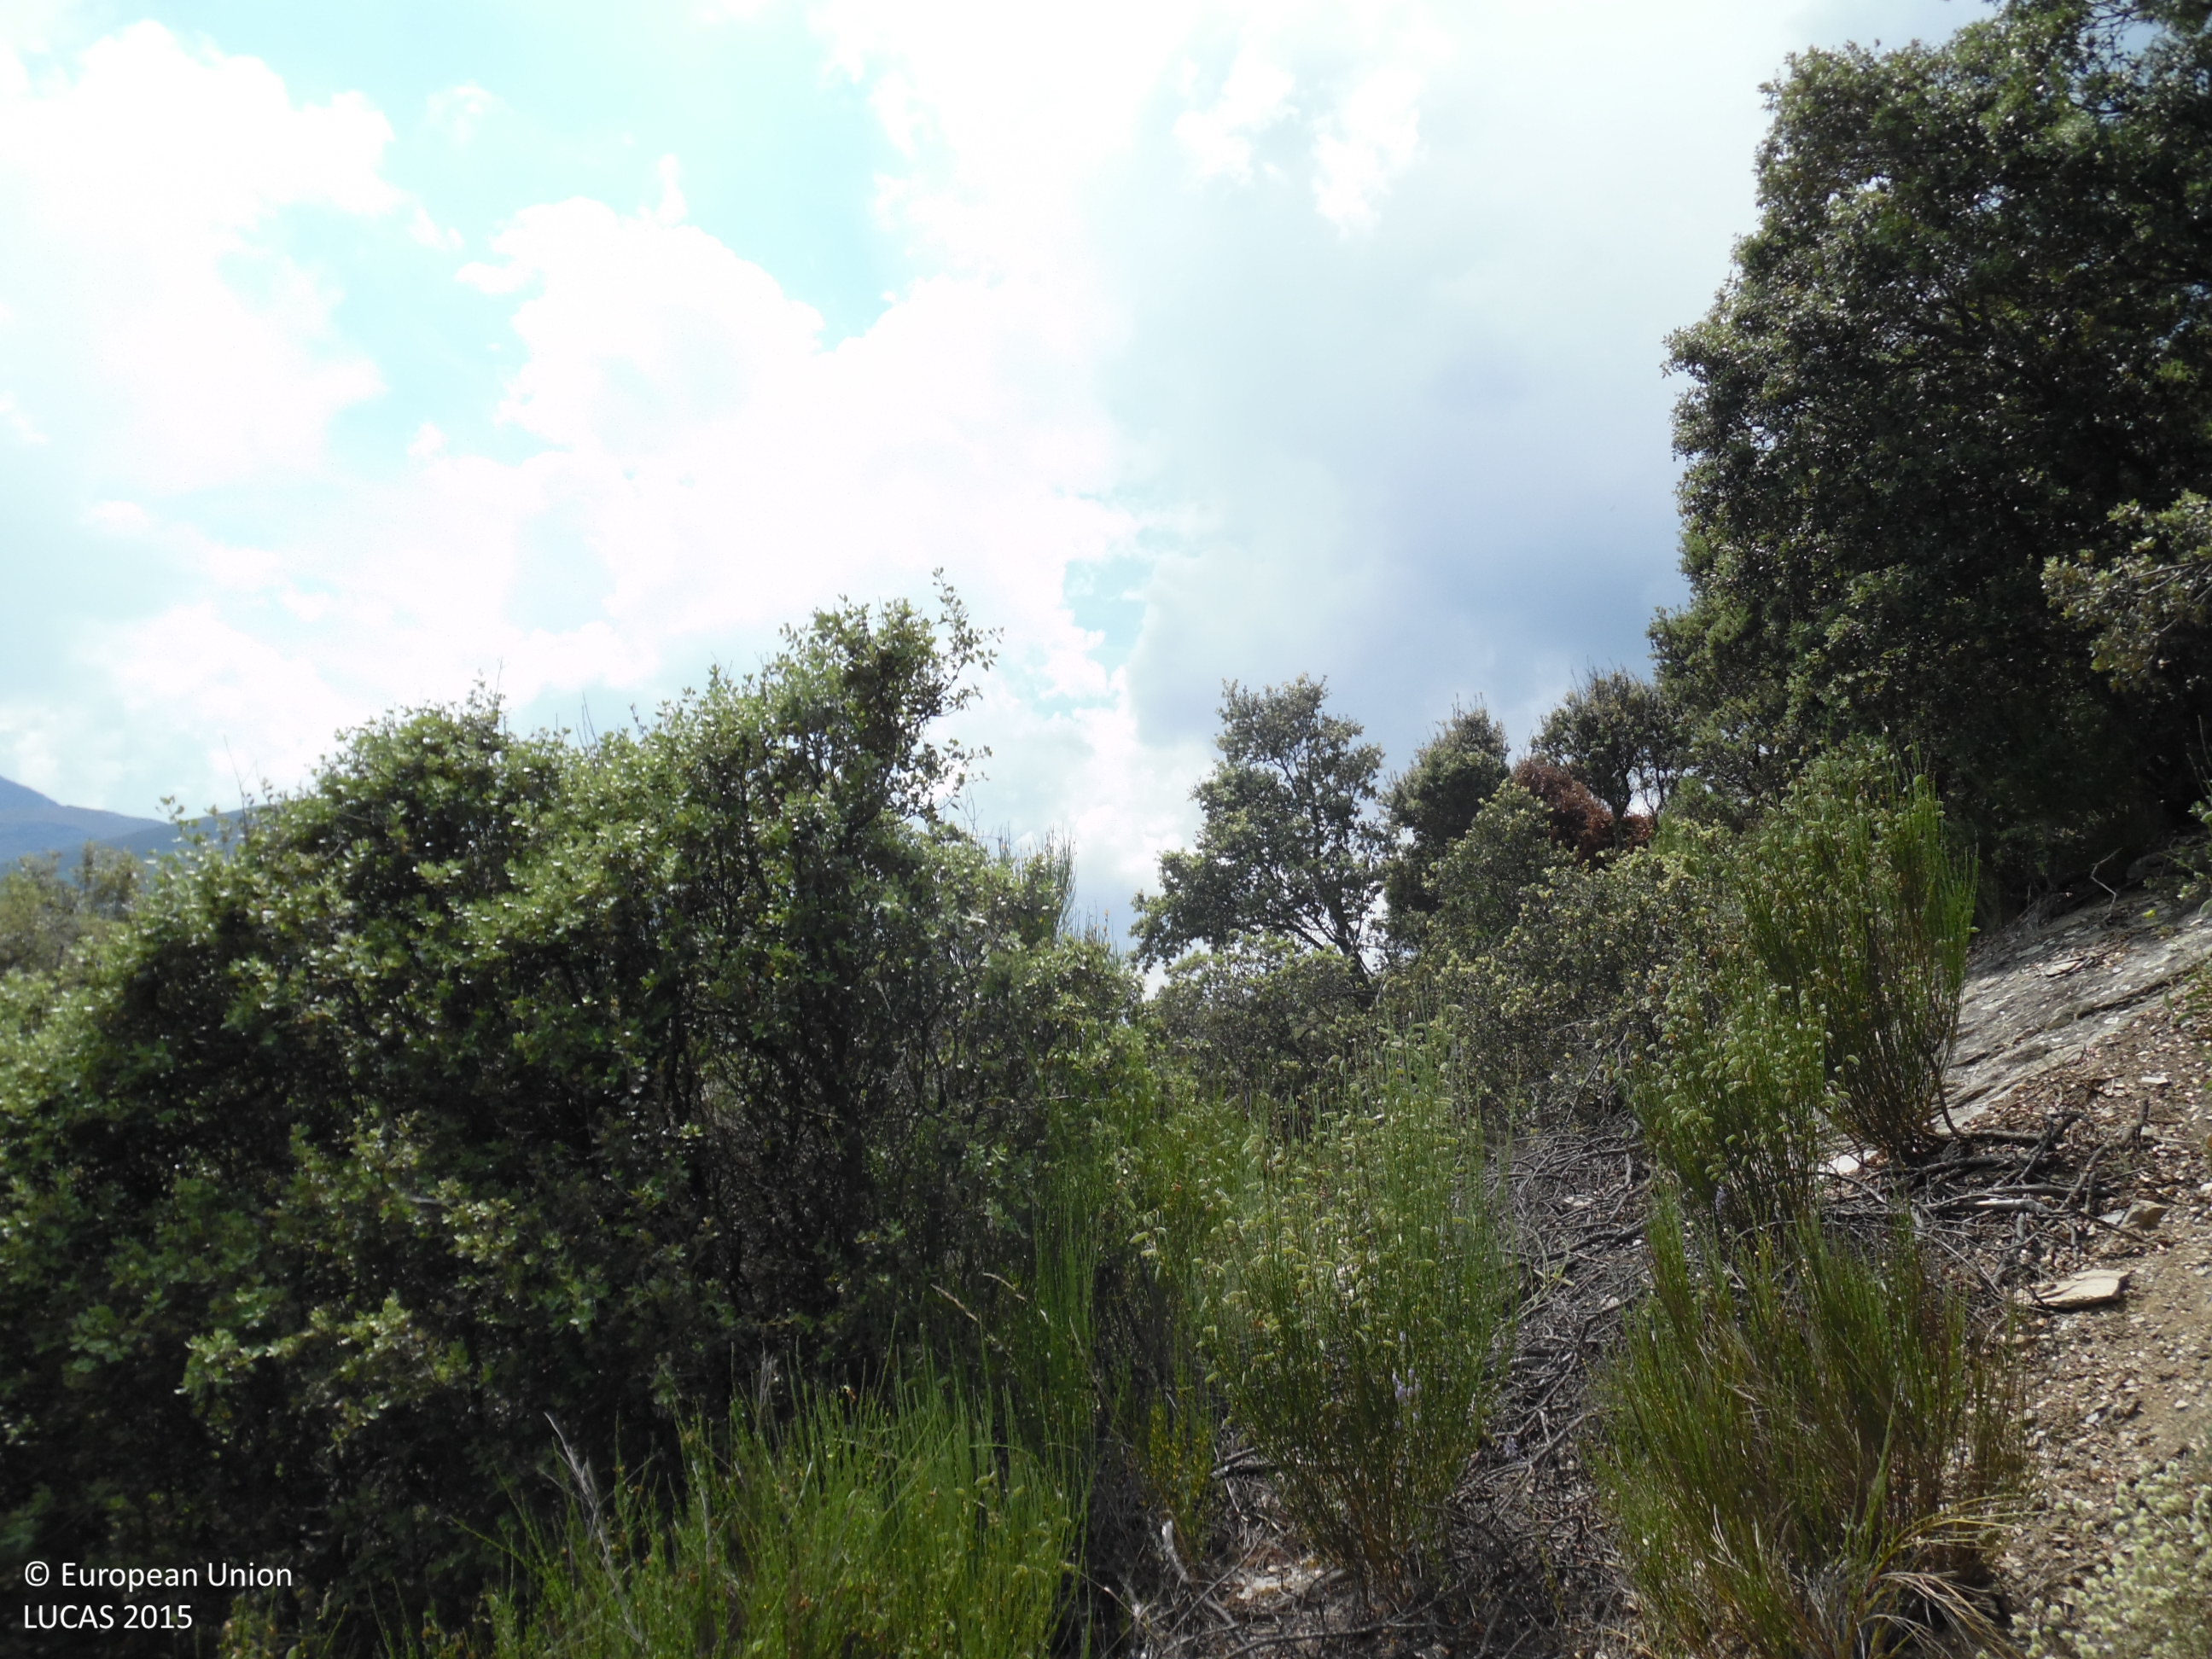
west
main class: Woodland
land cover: Broadleaved woodland
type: broadleaved evergreen forest
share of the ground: > 75 %
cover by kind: broadleaved forest trees 95 %, shrubs 5 %
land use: Forestry
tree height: > 5 m
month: June
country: ES
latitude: 42.2639
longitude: -6.6156
